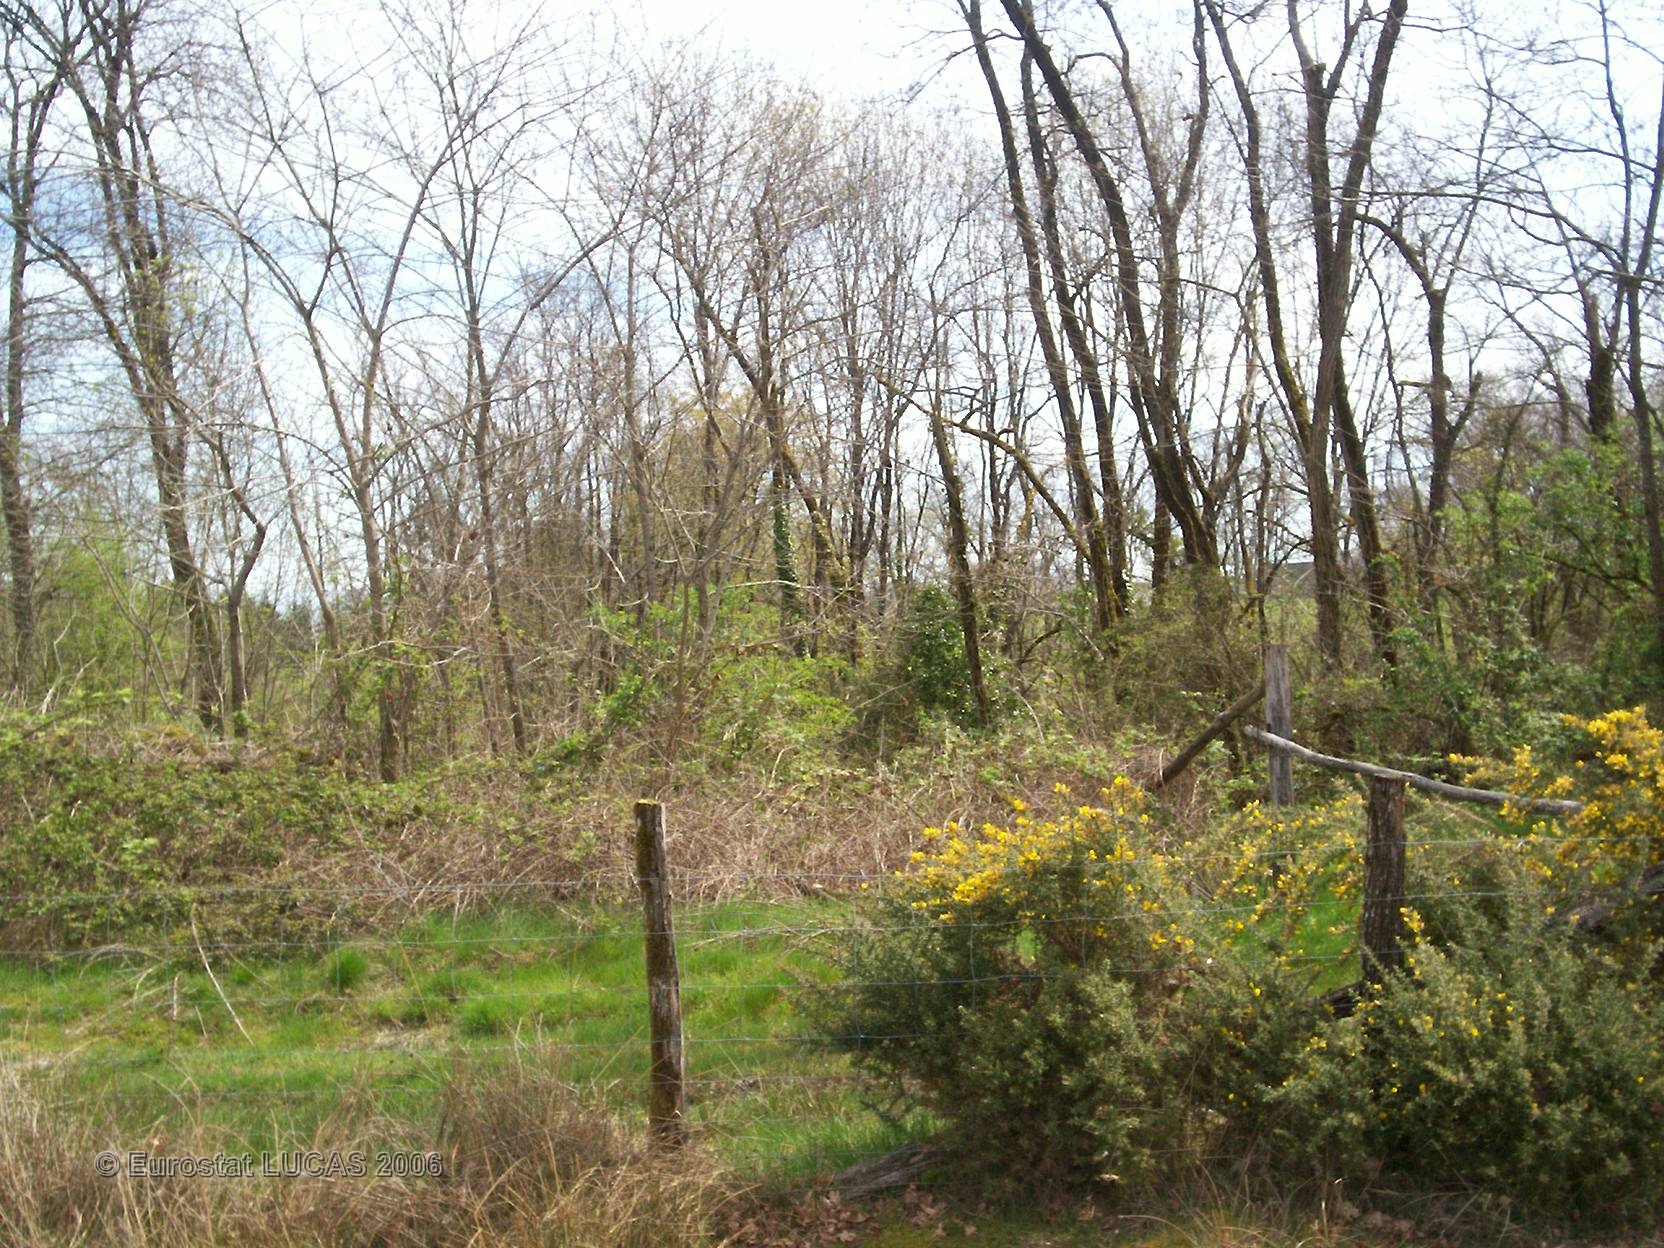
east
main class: Grassland
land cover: Grassland without tree/shrub cover
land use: Agriculture (excluding fallow land and kitchen gardens)
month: April
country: FR
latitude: 45.1811
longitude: 1.3020
